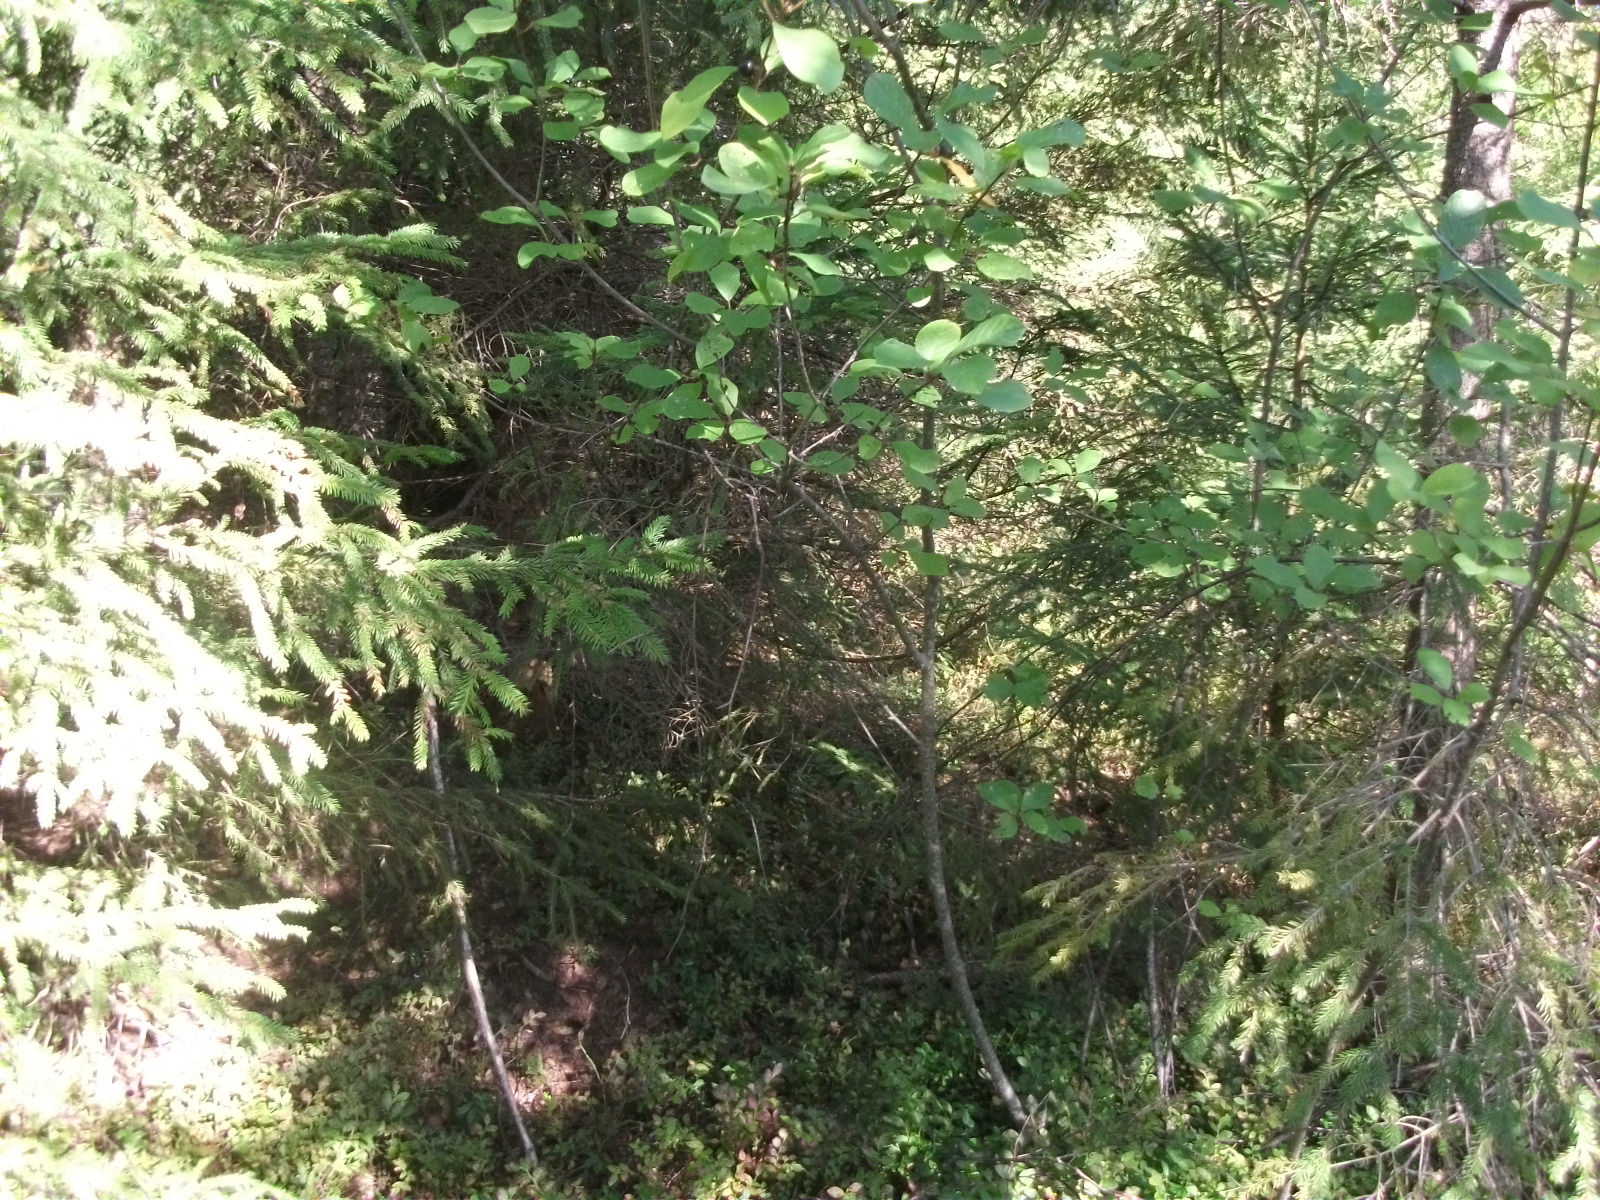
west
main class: Woodland
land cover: Spruce dominated mixed woodland
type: hemiboreal forest and nemoral coniferous forest and mixed broadleaved-coniferous forest
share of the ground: > 75 %
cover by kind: coniferous forest trees 55 %, broadleaved forest trees 25 %, herbaceous plants 15 %, shrubs 5 %
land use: Forestry
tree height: > 5 m
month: August
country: LV
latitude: 56.4338
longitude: 26.2109
